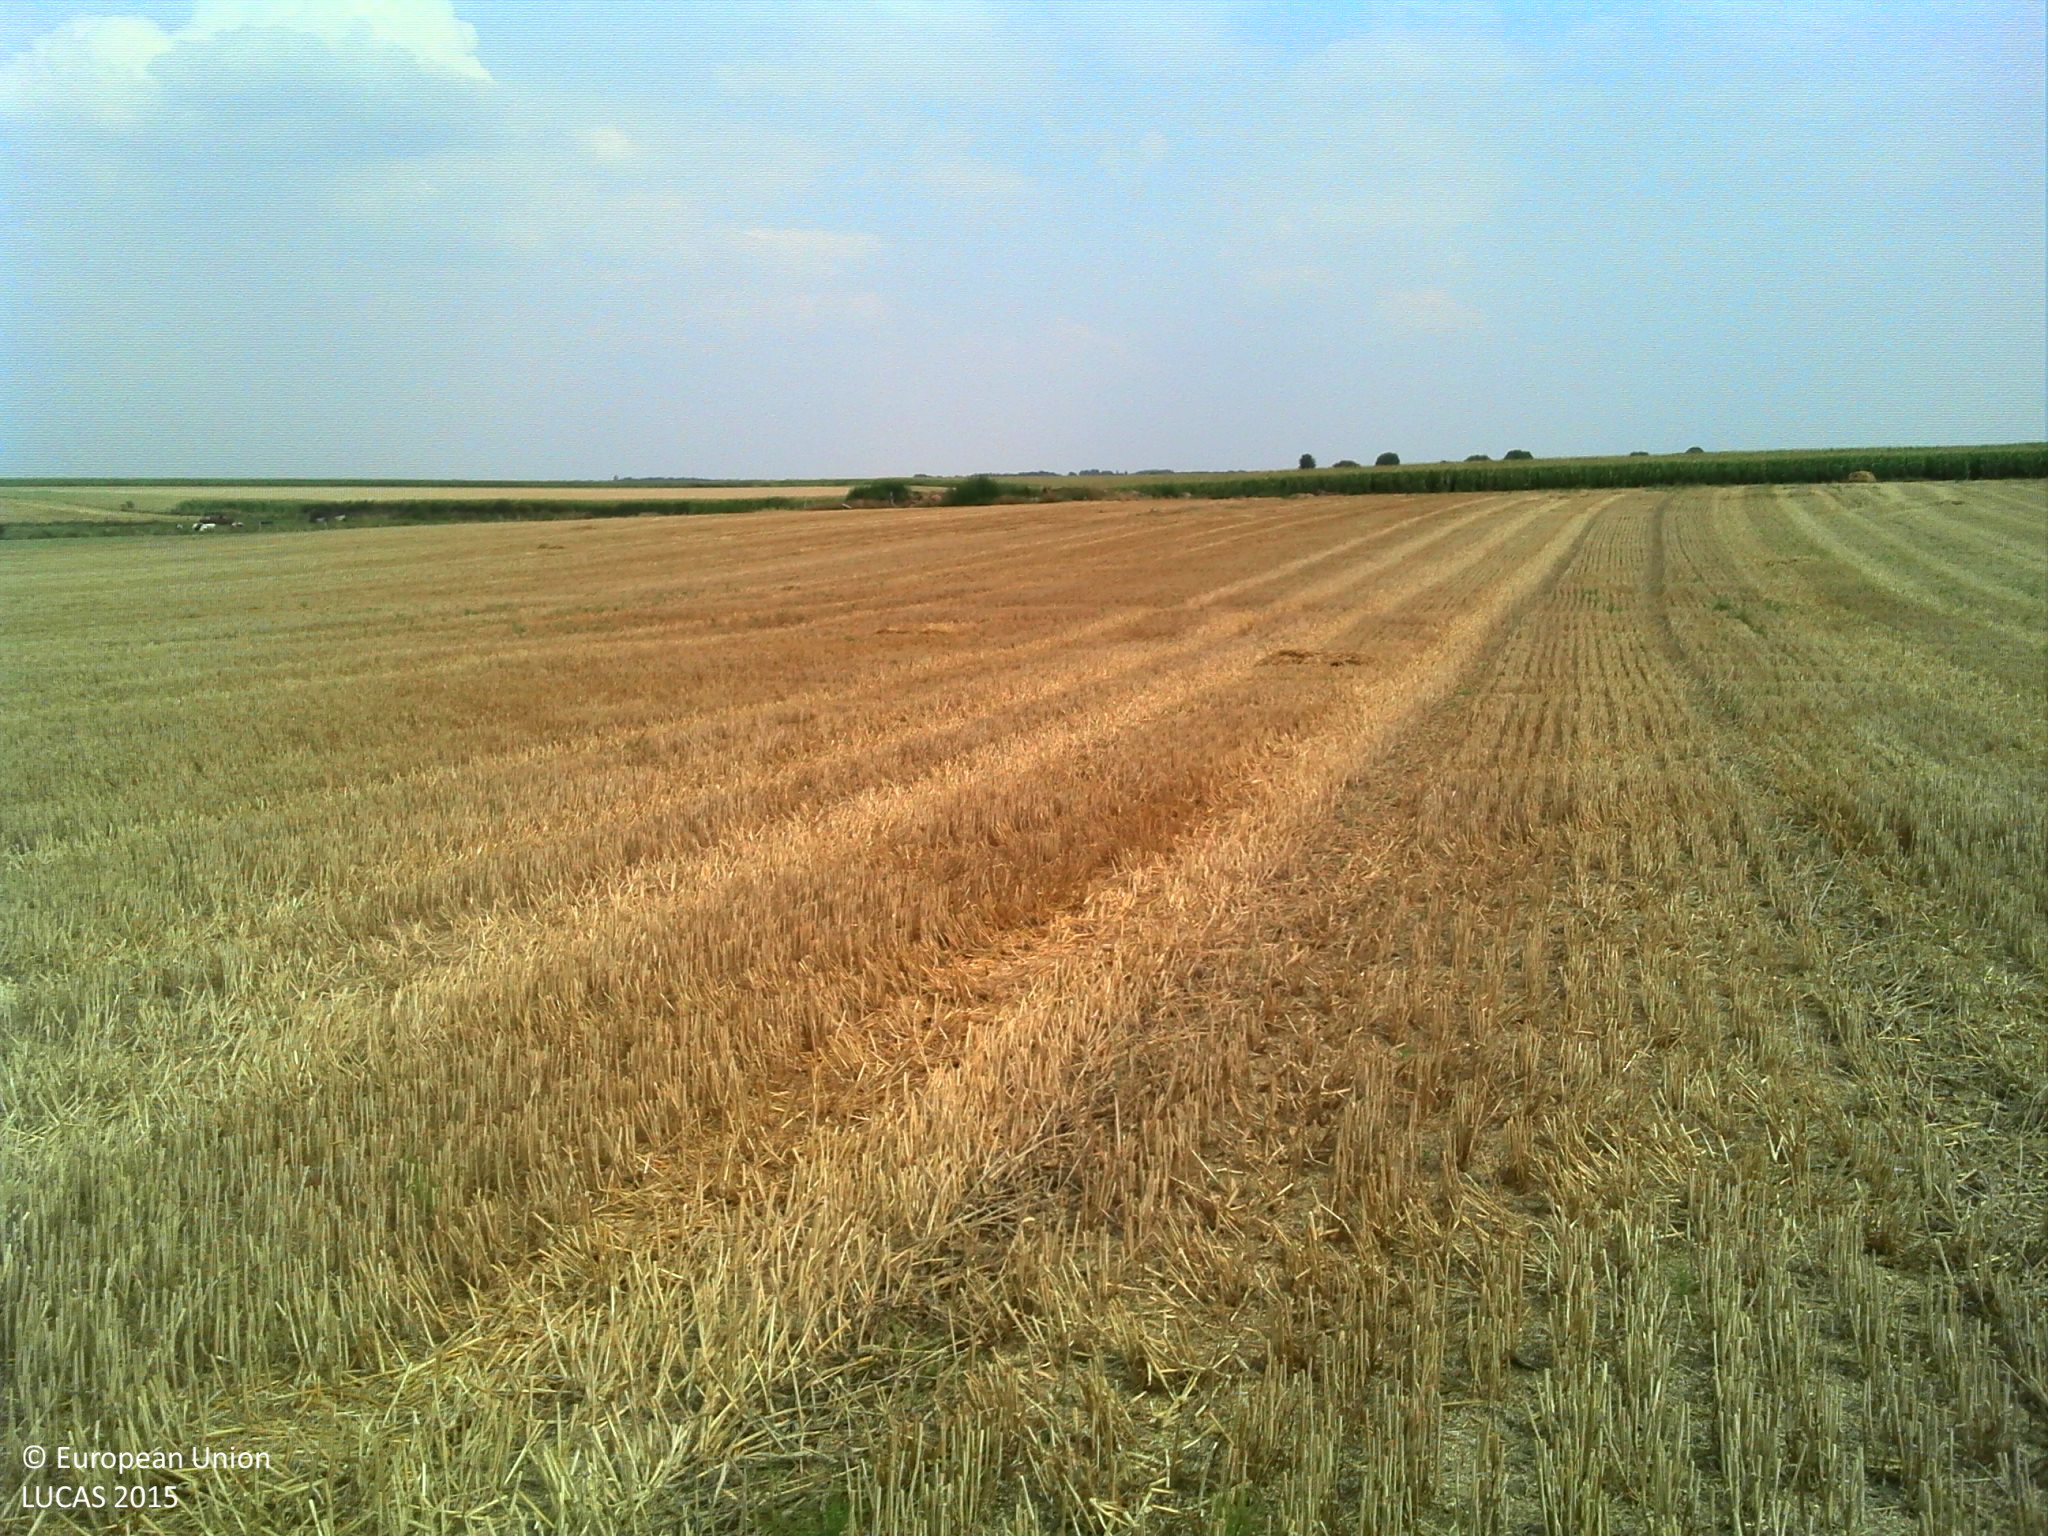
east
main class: Cropland
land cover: Common wheat
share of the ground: 10 - 25 %
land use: Agriculture (excluding fallow land and kitchen gardens)
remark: Harvested field
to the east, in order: Common wheat; Spontaneously vegetated surfaces; Tracks; Grass margins; Maize
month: August
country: FR
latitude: 50.2039
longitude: 3.6180
